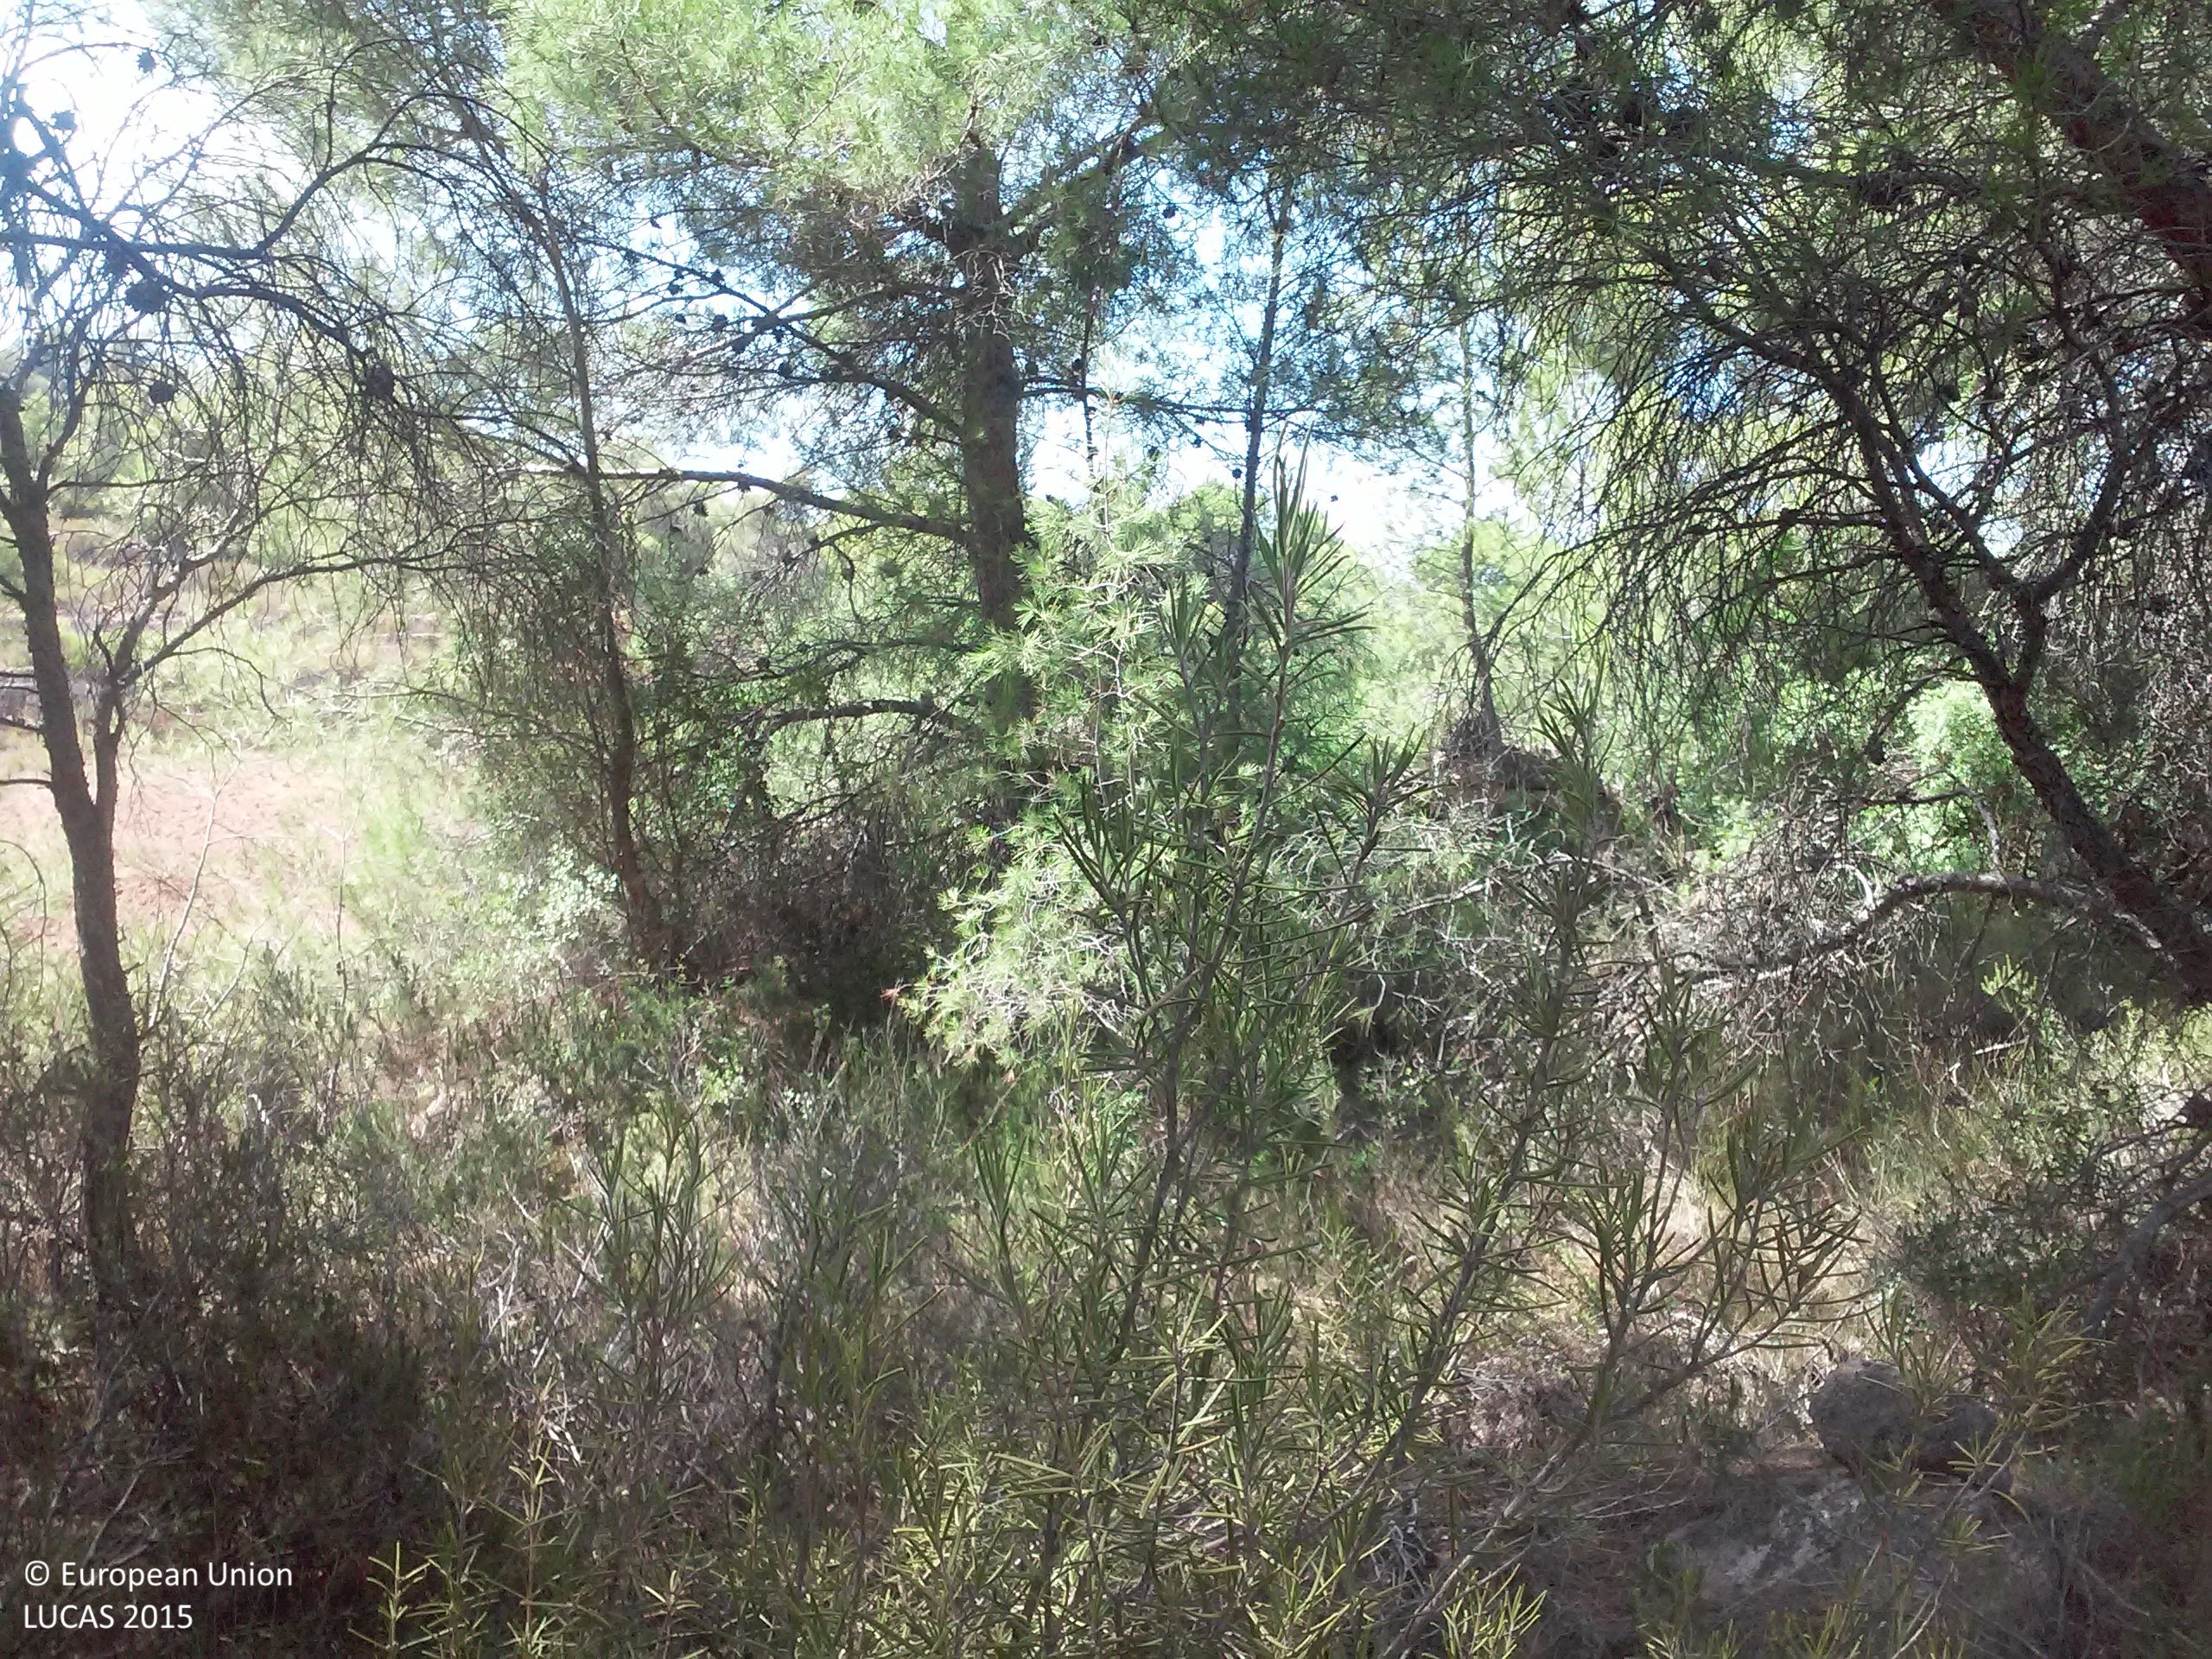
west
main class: Woodland
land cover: Pine dominated coniferous woodland
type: coniferous forest of the mediterranean region
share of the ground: 25 - 50 %
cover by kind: coniferous forest trees 40 %, shrubs 30 %, herbaceous plants 20 %, lichens and mosses 10 %
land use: Semi-natural and natural areas not in use
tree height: > 5 m
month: August
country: ES
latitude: 41.1358
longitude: 0.5203
